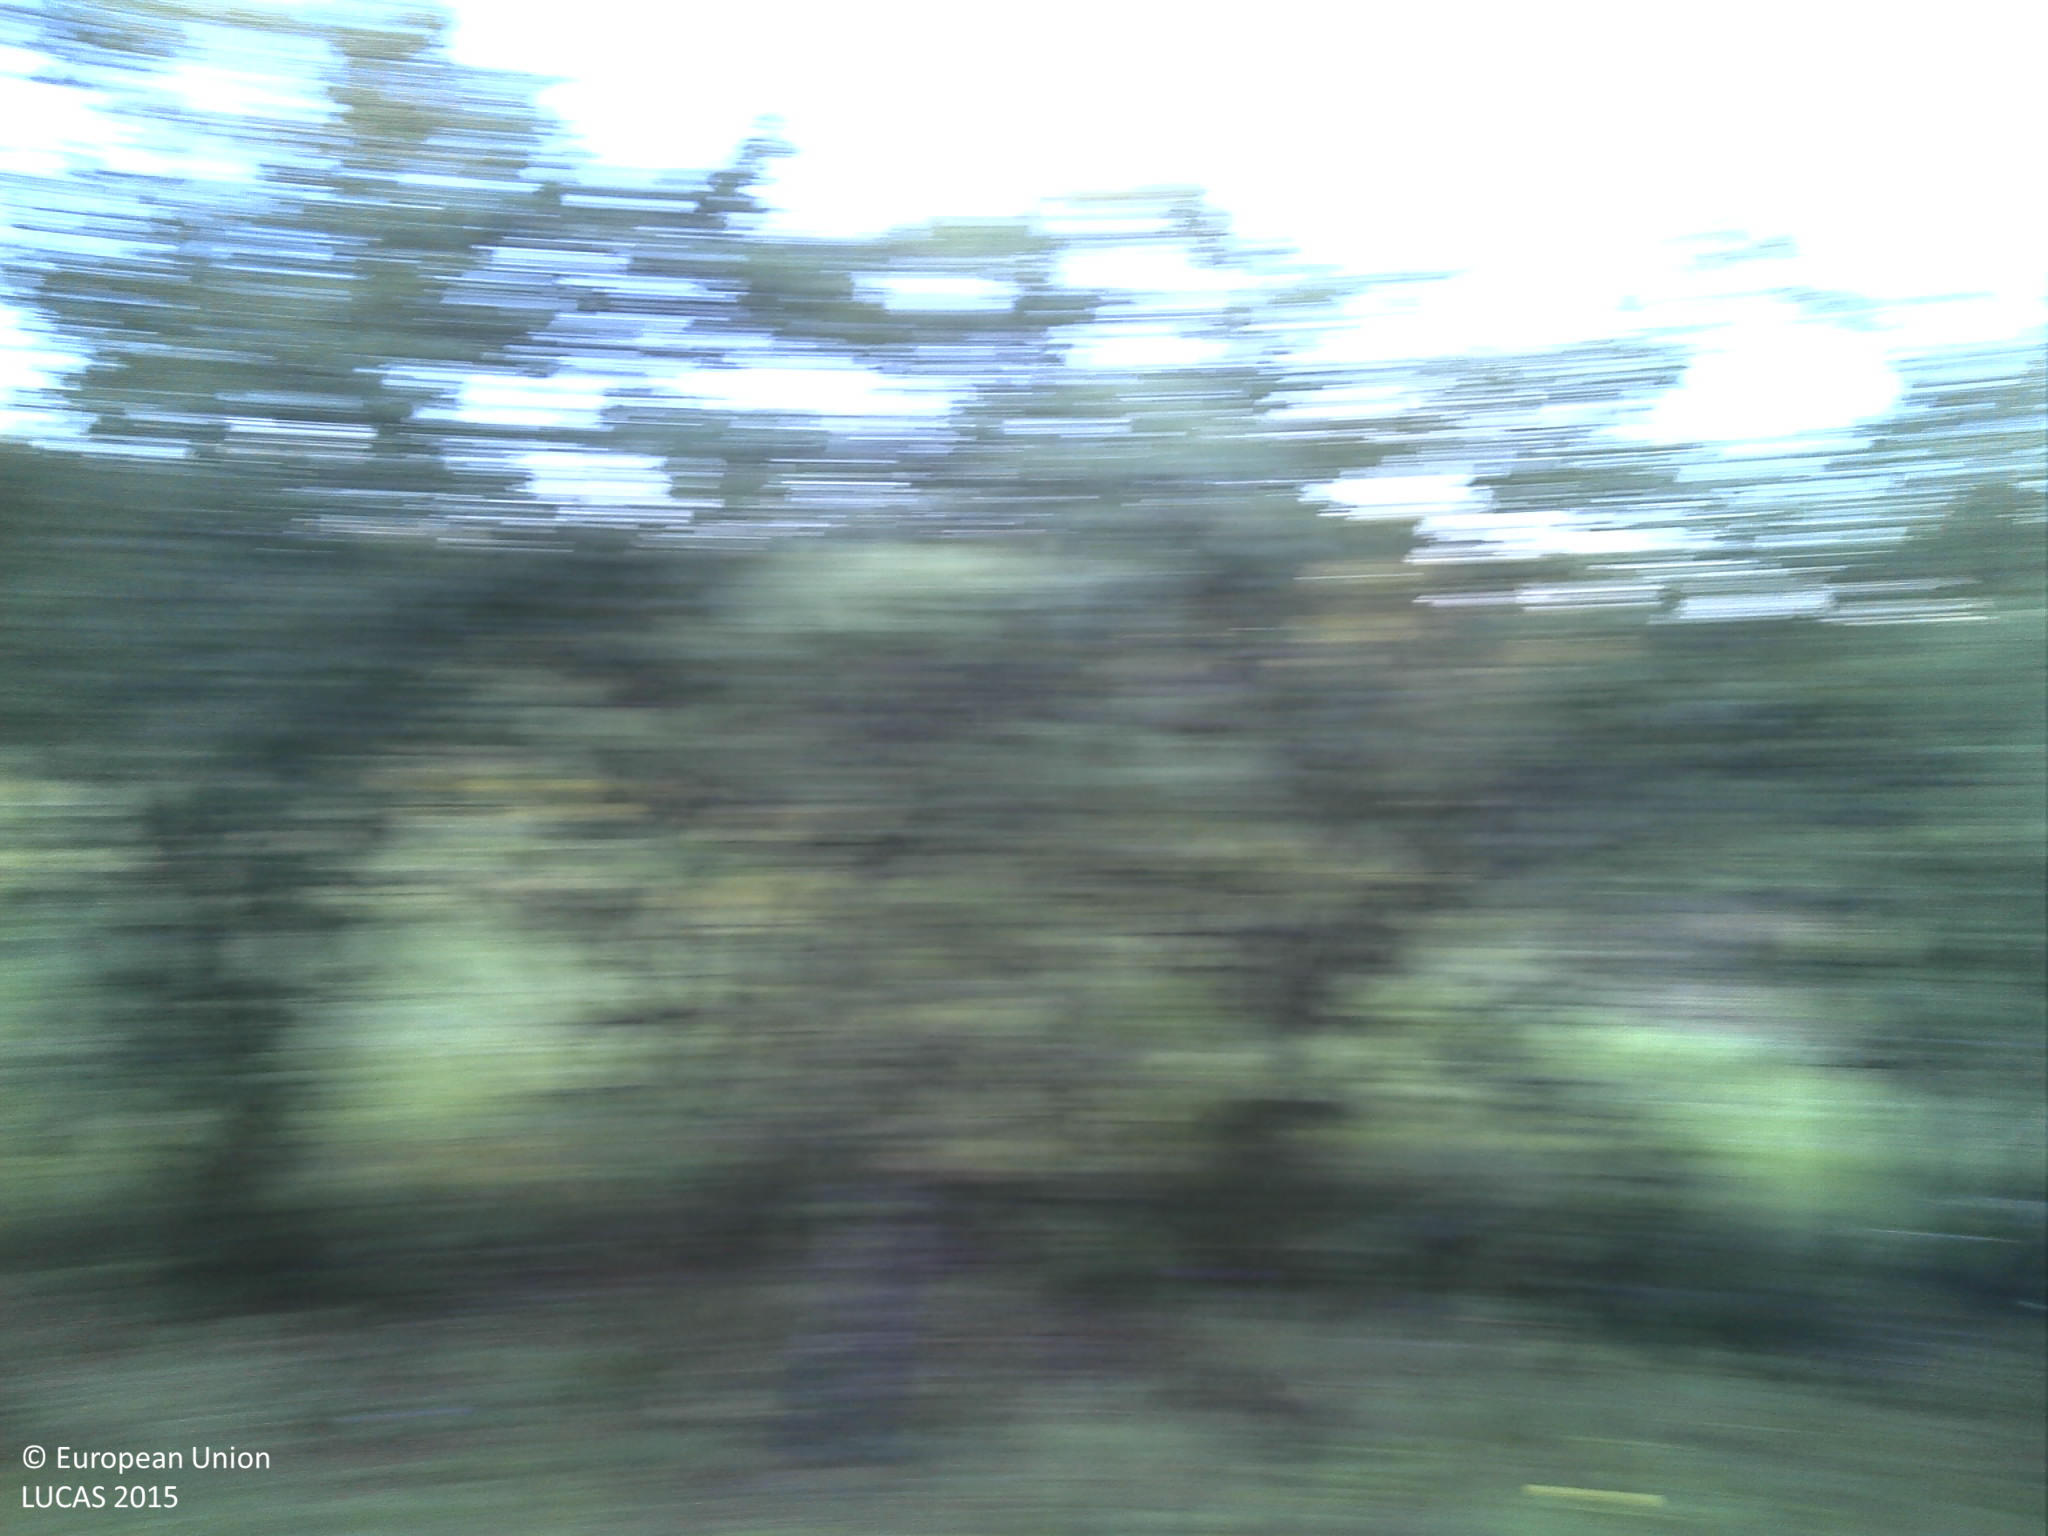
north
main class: Woodland
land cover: Broadleaved woodland
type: broadleaved evergreen forest
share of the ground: 25 - 50 %
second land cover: Grassland without tree/shrub cover
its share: 50 - 75 %
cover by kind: herbaceous plants 50 %, broadleaved forest trees 30 %, unconsolidated bare surface 15 %, shrubs 5 %
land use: Forestry
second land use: Agriculture (excluding fallow land and kitchen gardens)
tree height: > 5 m
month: May
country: PT
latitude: 39.1063
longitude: -7.8925
